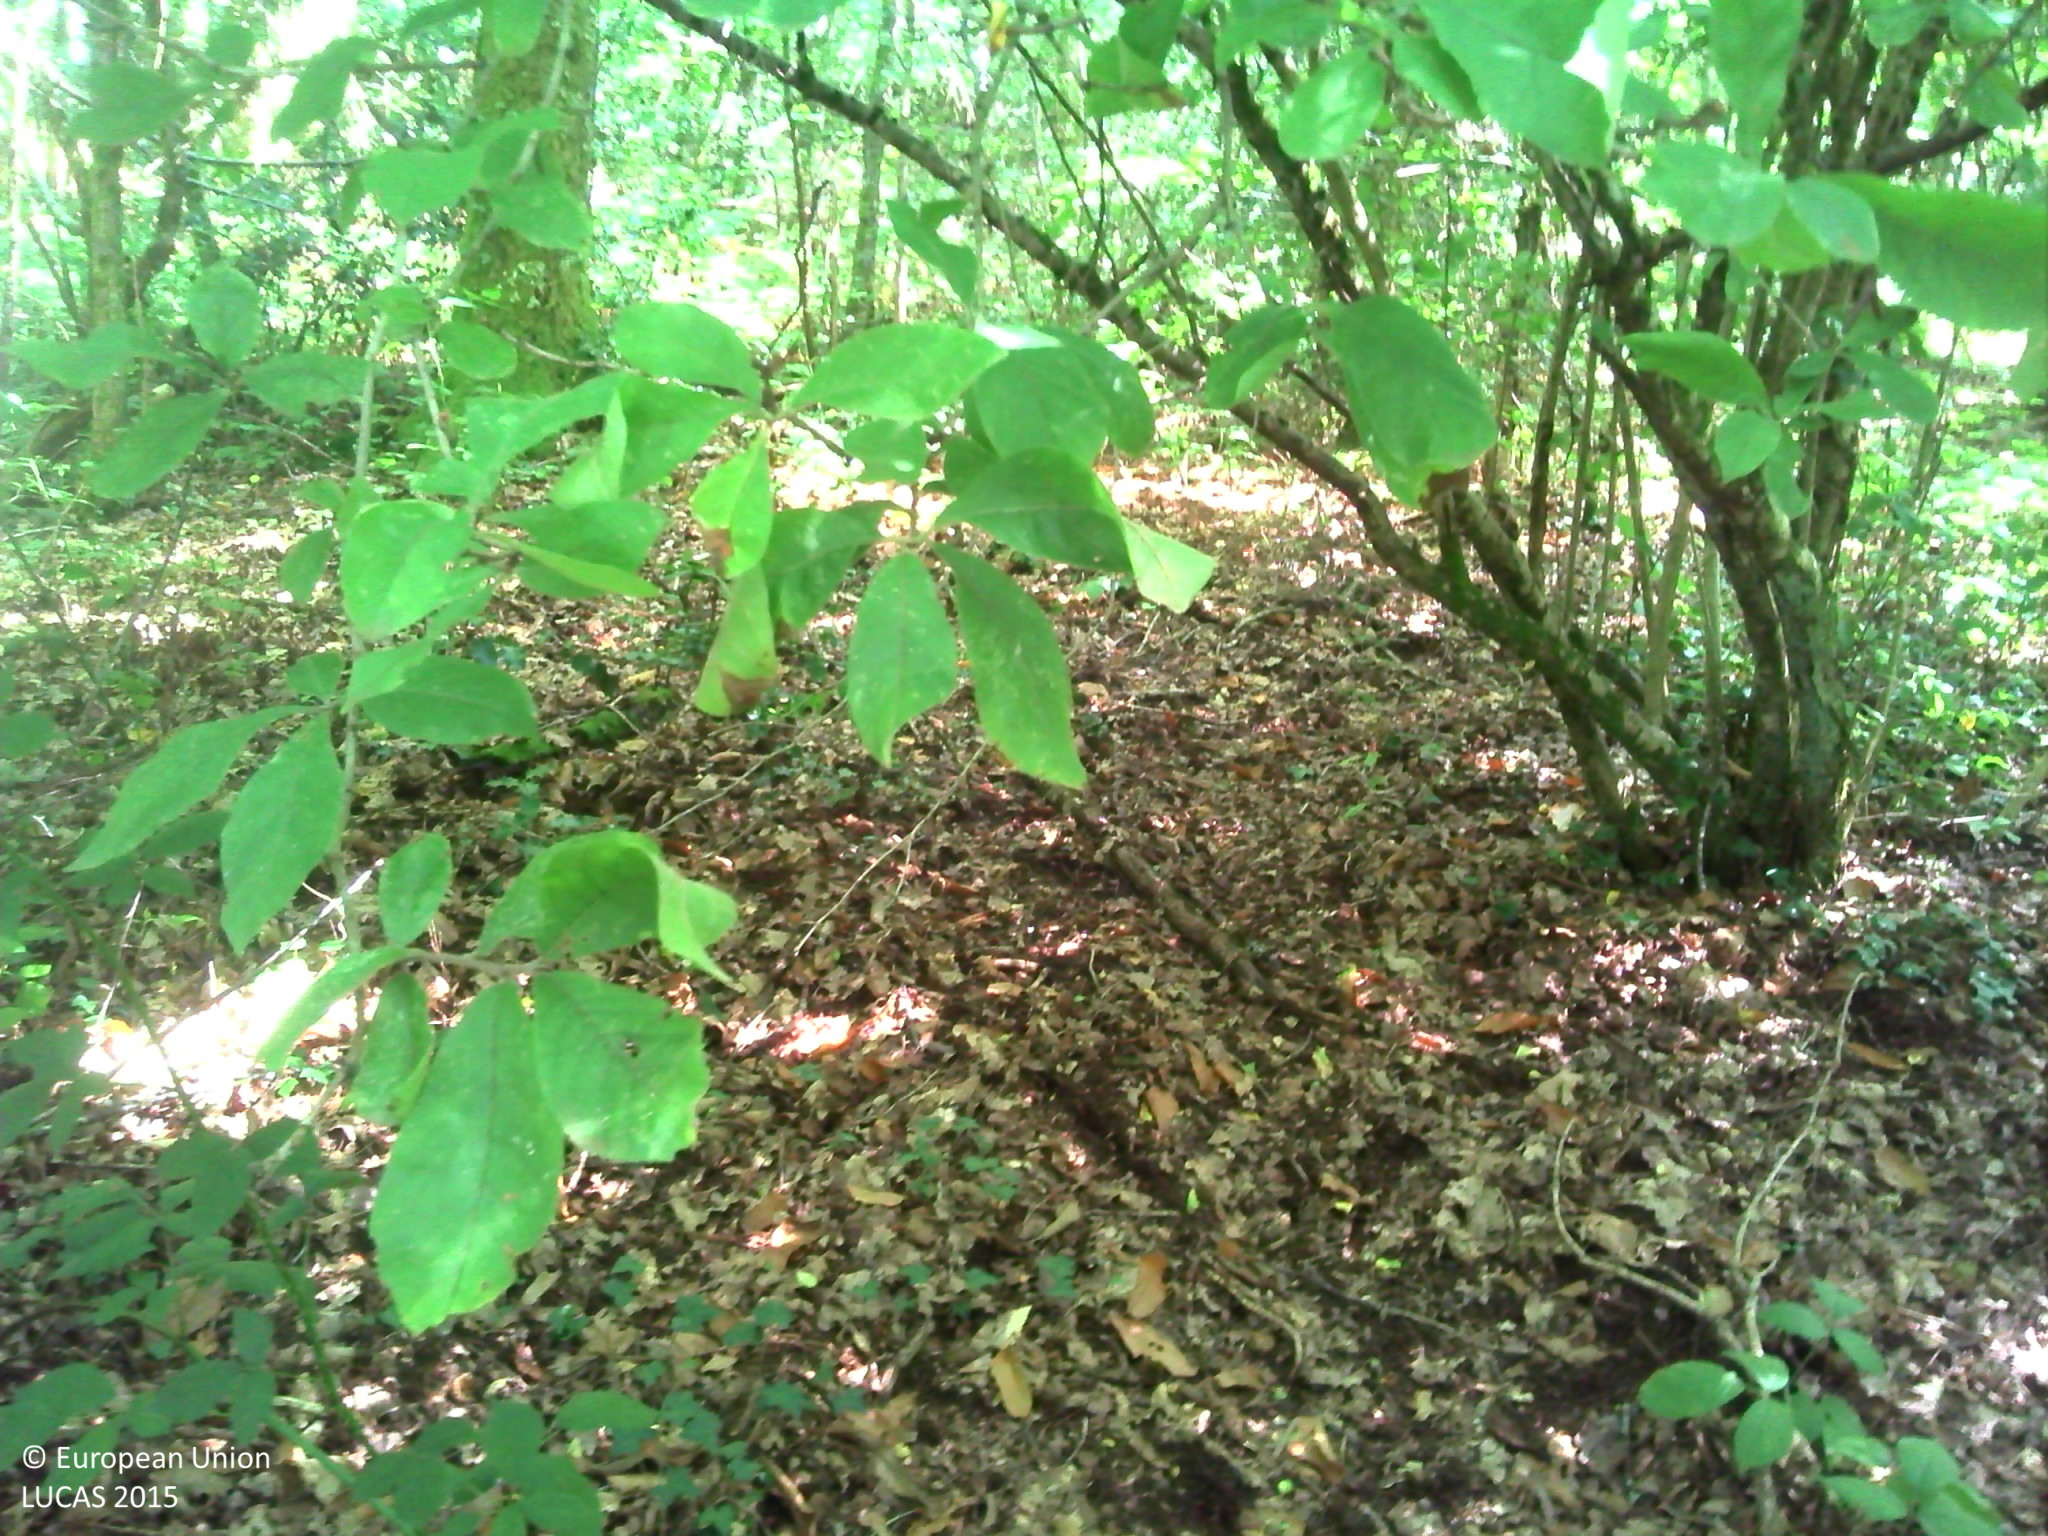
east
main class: Woodland
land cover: Broadleaved woodland
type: mesophytic deciduous forest
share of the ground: > 75 %
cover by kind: broadleaved forest trees 70 %, herbaceous plants 20 %, coniferous forest trees 10 %
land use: Abandoned areas
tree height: > 5 m
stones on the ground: < 10 %
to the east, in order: Broadleaved woodland; Fences; Grassland with sparse tree/shrub cover; Grassland without tree/shrub cover; Fences; Tracks; Fences; Grassland without tree/shrub cover
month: August
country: FR
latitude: 46.0614
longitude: 1.2123
